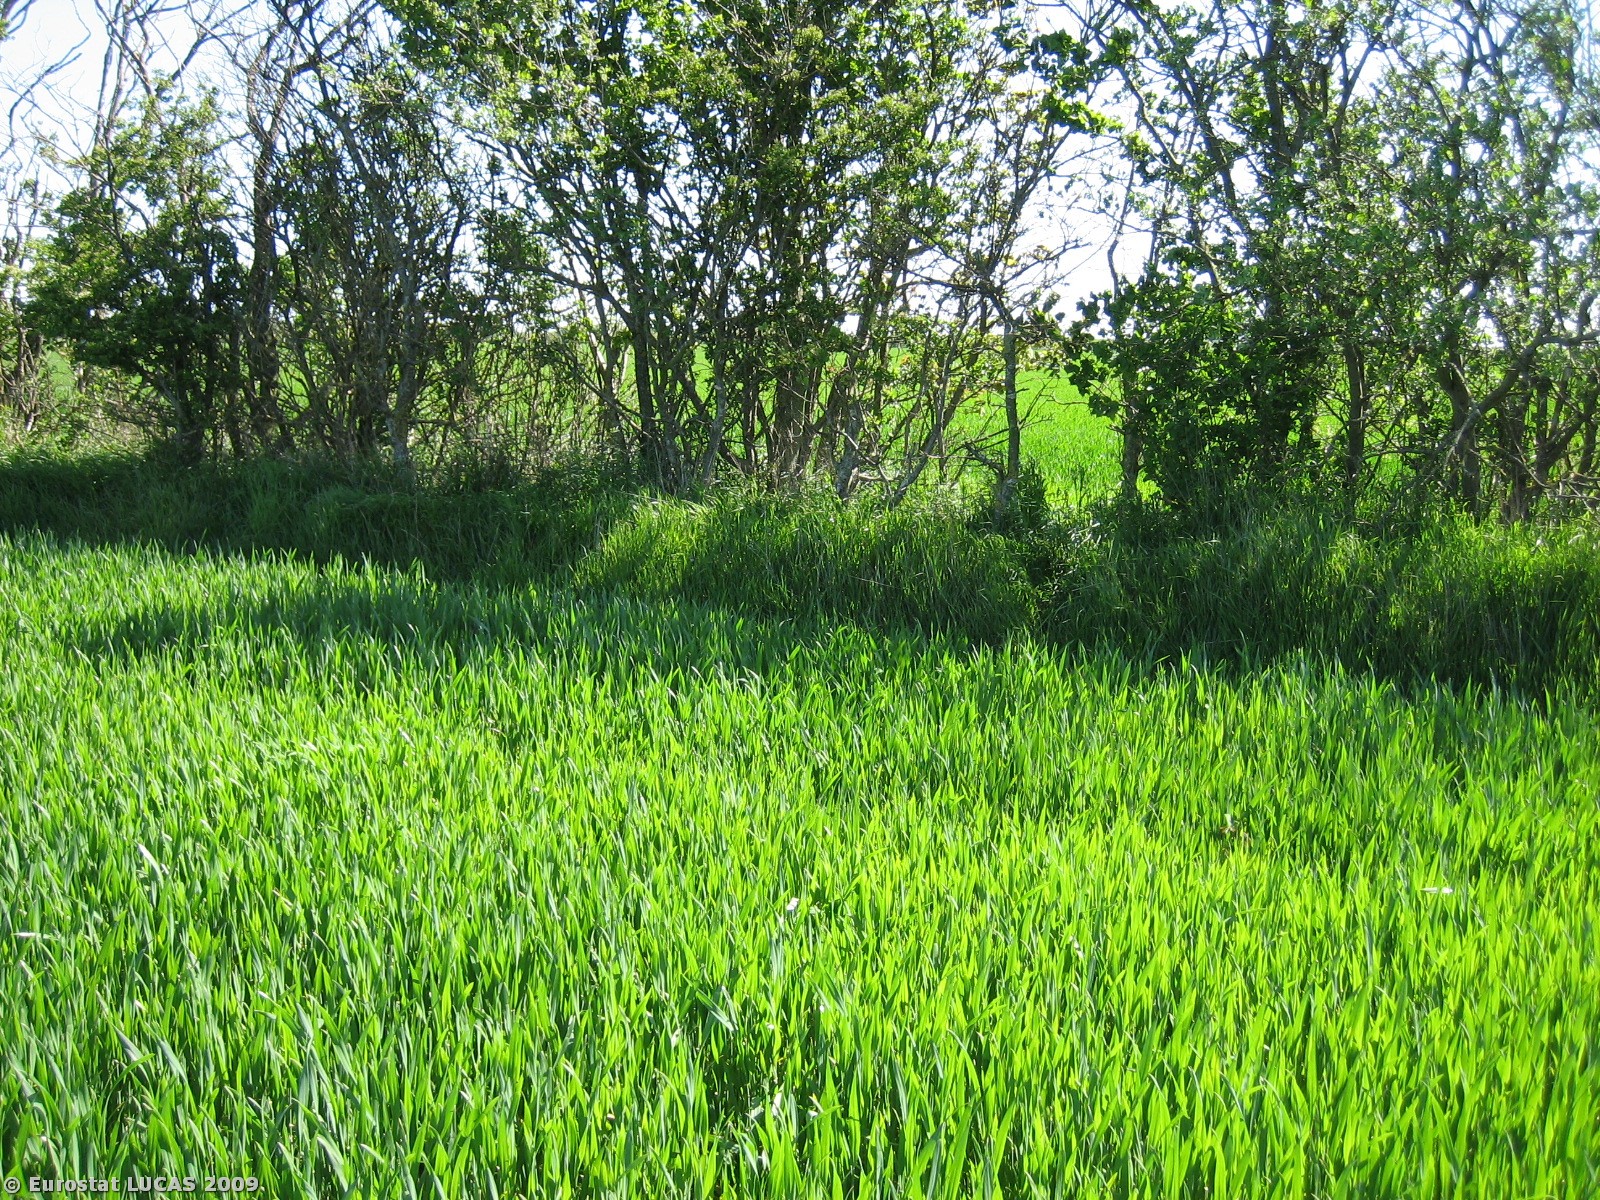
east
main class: Cropland
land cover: Common wheat
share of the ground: > 75 %
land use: Agriculture (excluding fallow land and kitchen gardens)
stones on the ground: < 10 %
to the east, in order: Common wheat; Broadleaved woodland; Common wheat
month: May
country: DK
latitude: 55.9443
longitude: 8.4165
